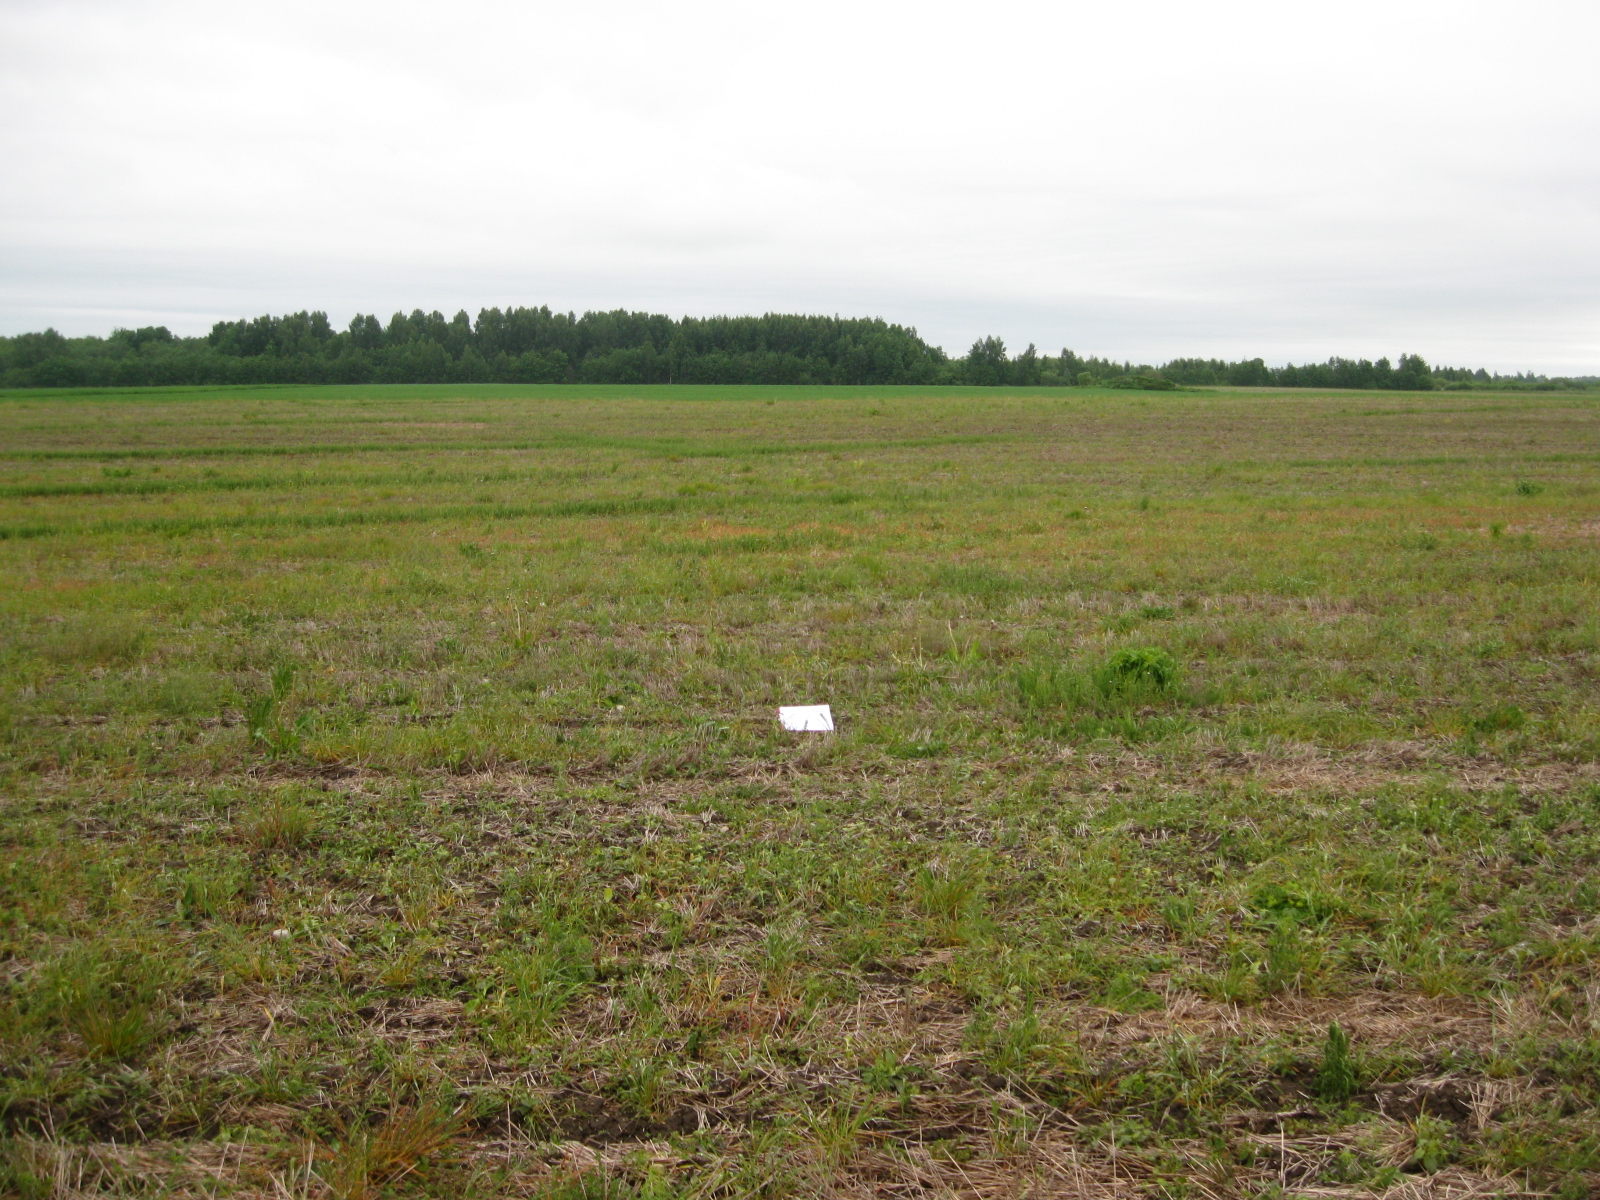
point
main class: Grassland
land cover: Spontaneously vegetated surfaces
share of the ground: 50 - 75 %
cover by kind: herbaceous plants 70 %, unconsolidated bare surface 30 %
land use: Fallow land
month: June
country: LT
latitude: 55.9380
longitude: 24.0648
